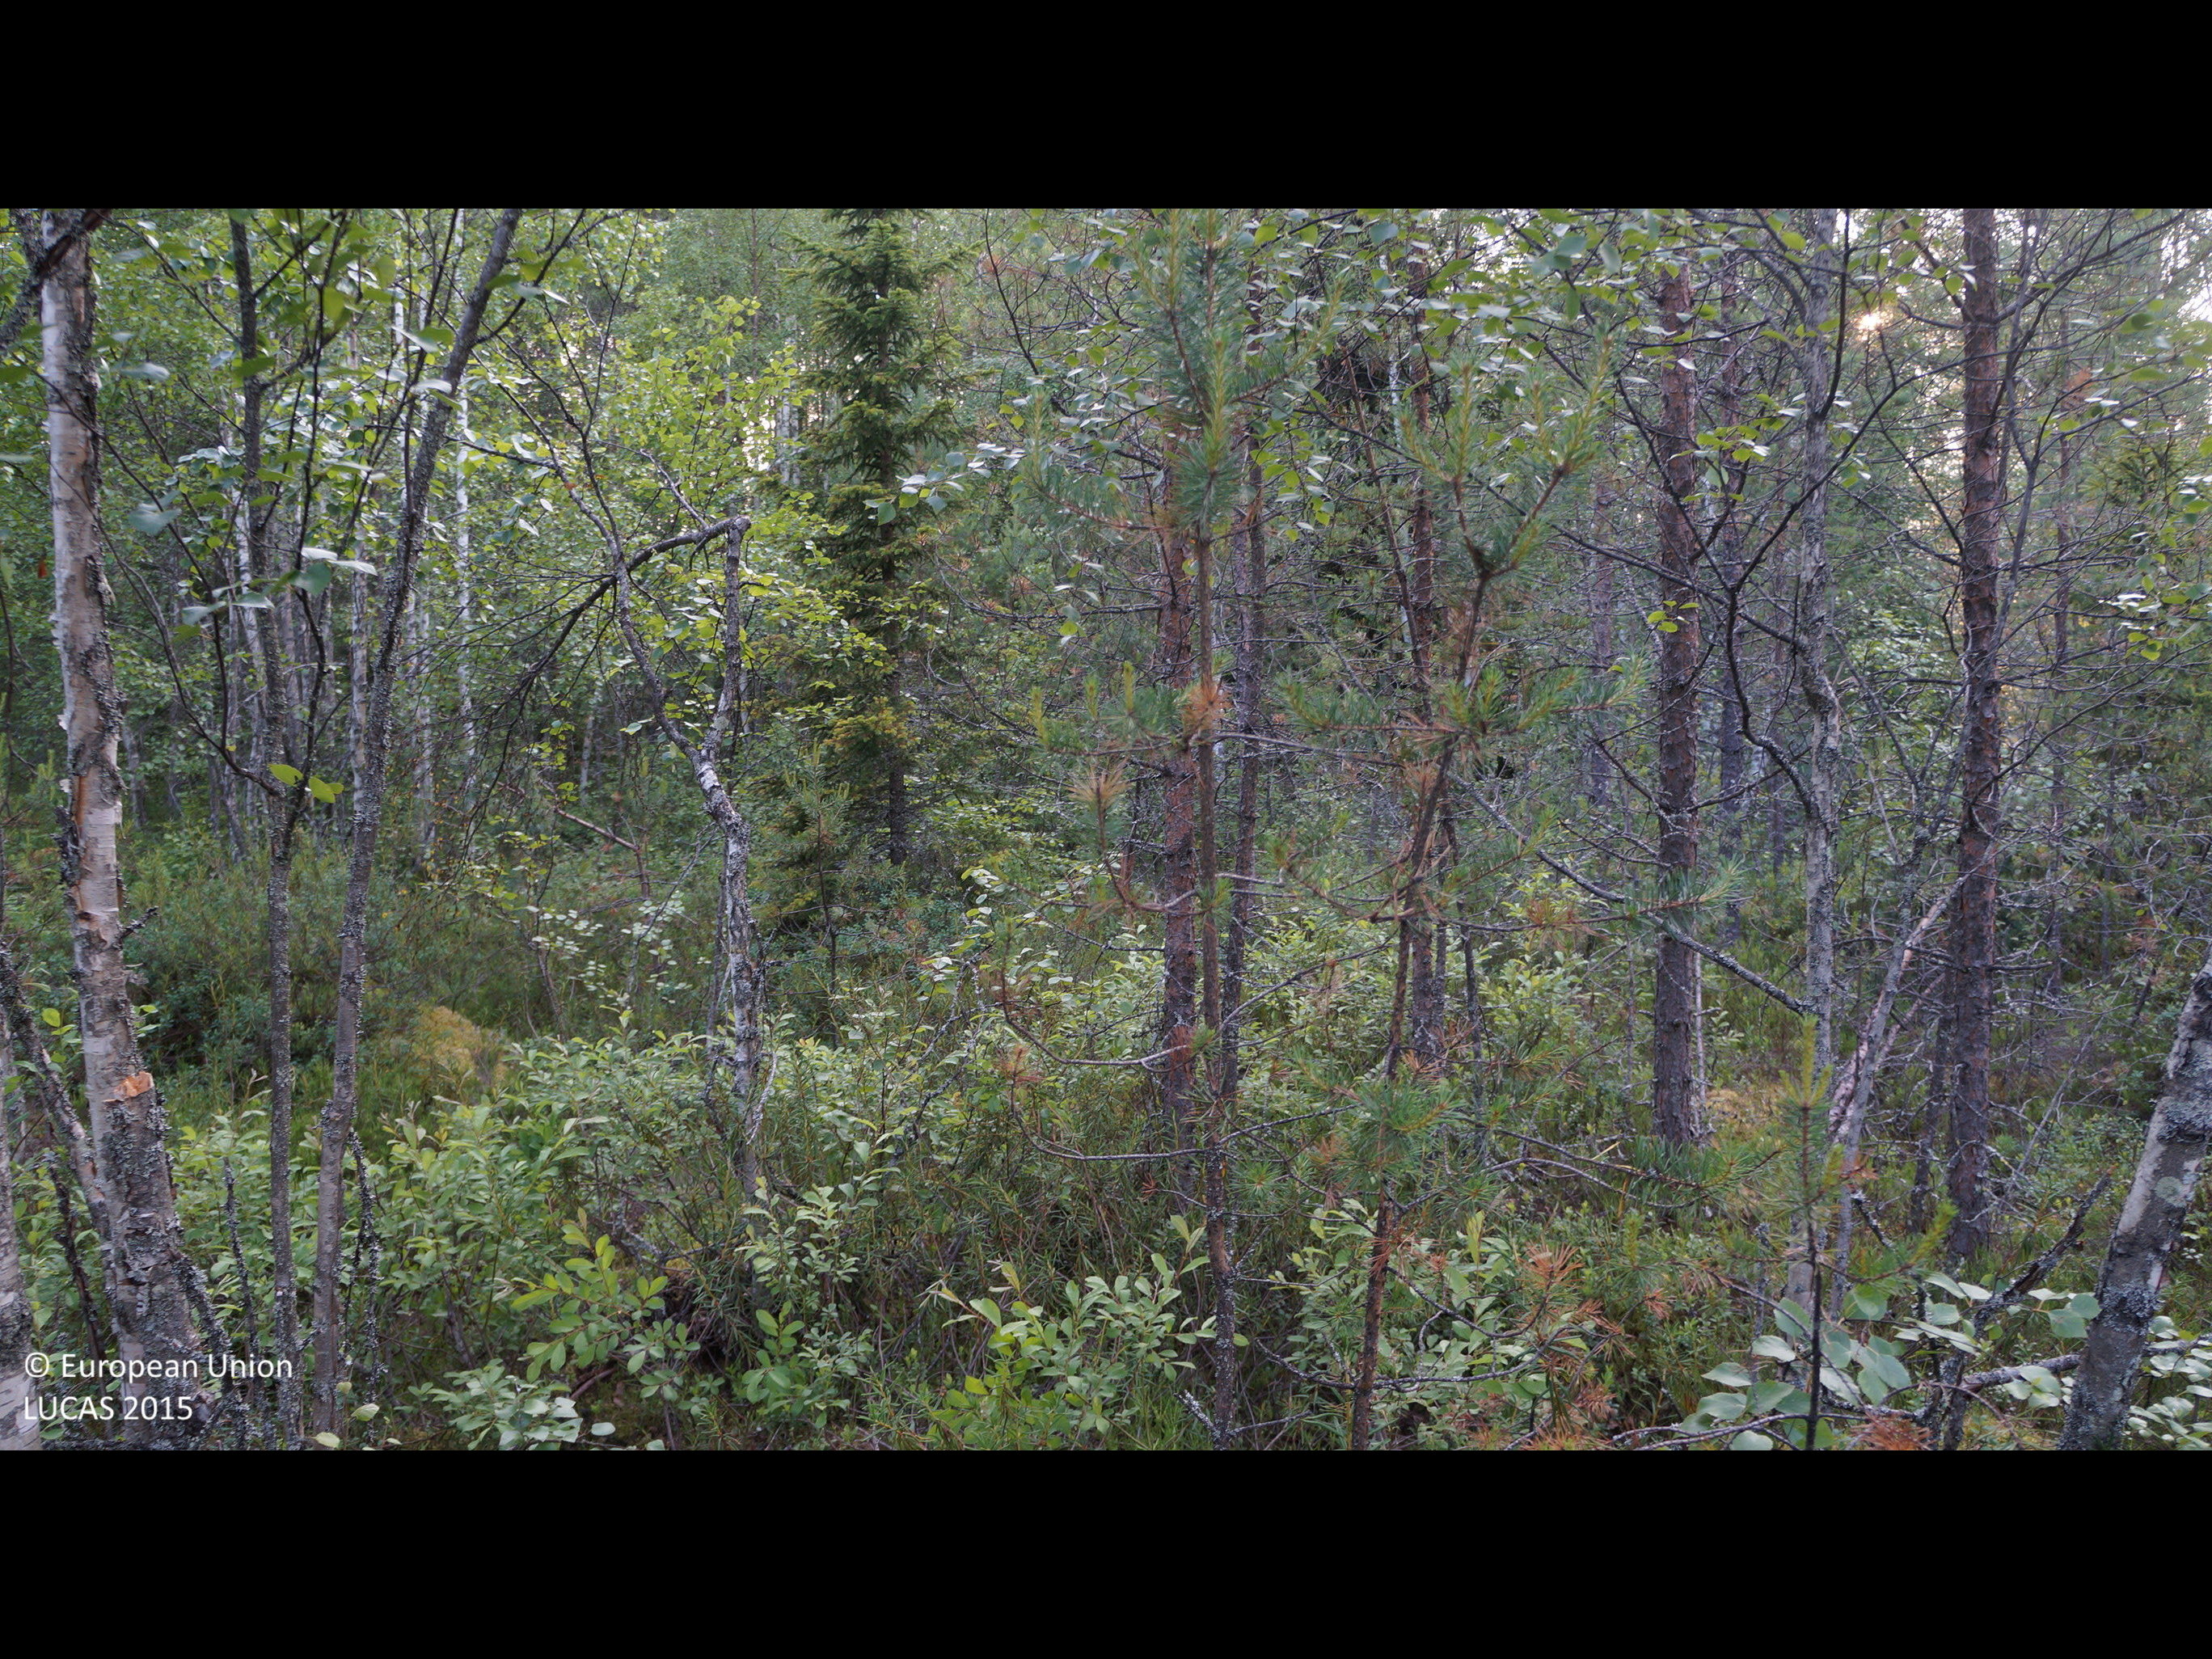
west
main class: Woodland
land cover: Pine dominated mixed woodland
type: boreal forest
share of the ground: 50 - 75 %
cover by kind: shrubs 40 %, coniferous forest trees 35 %, broadleaved forest trees 15 %, lichens and mosses 10 %
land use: Forestry
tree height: > 5 m
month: July
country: FI
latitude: 63.7734
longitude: 24.0014
